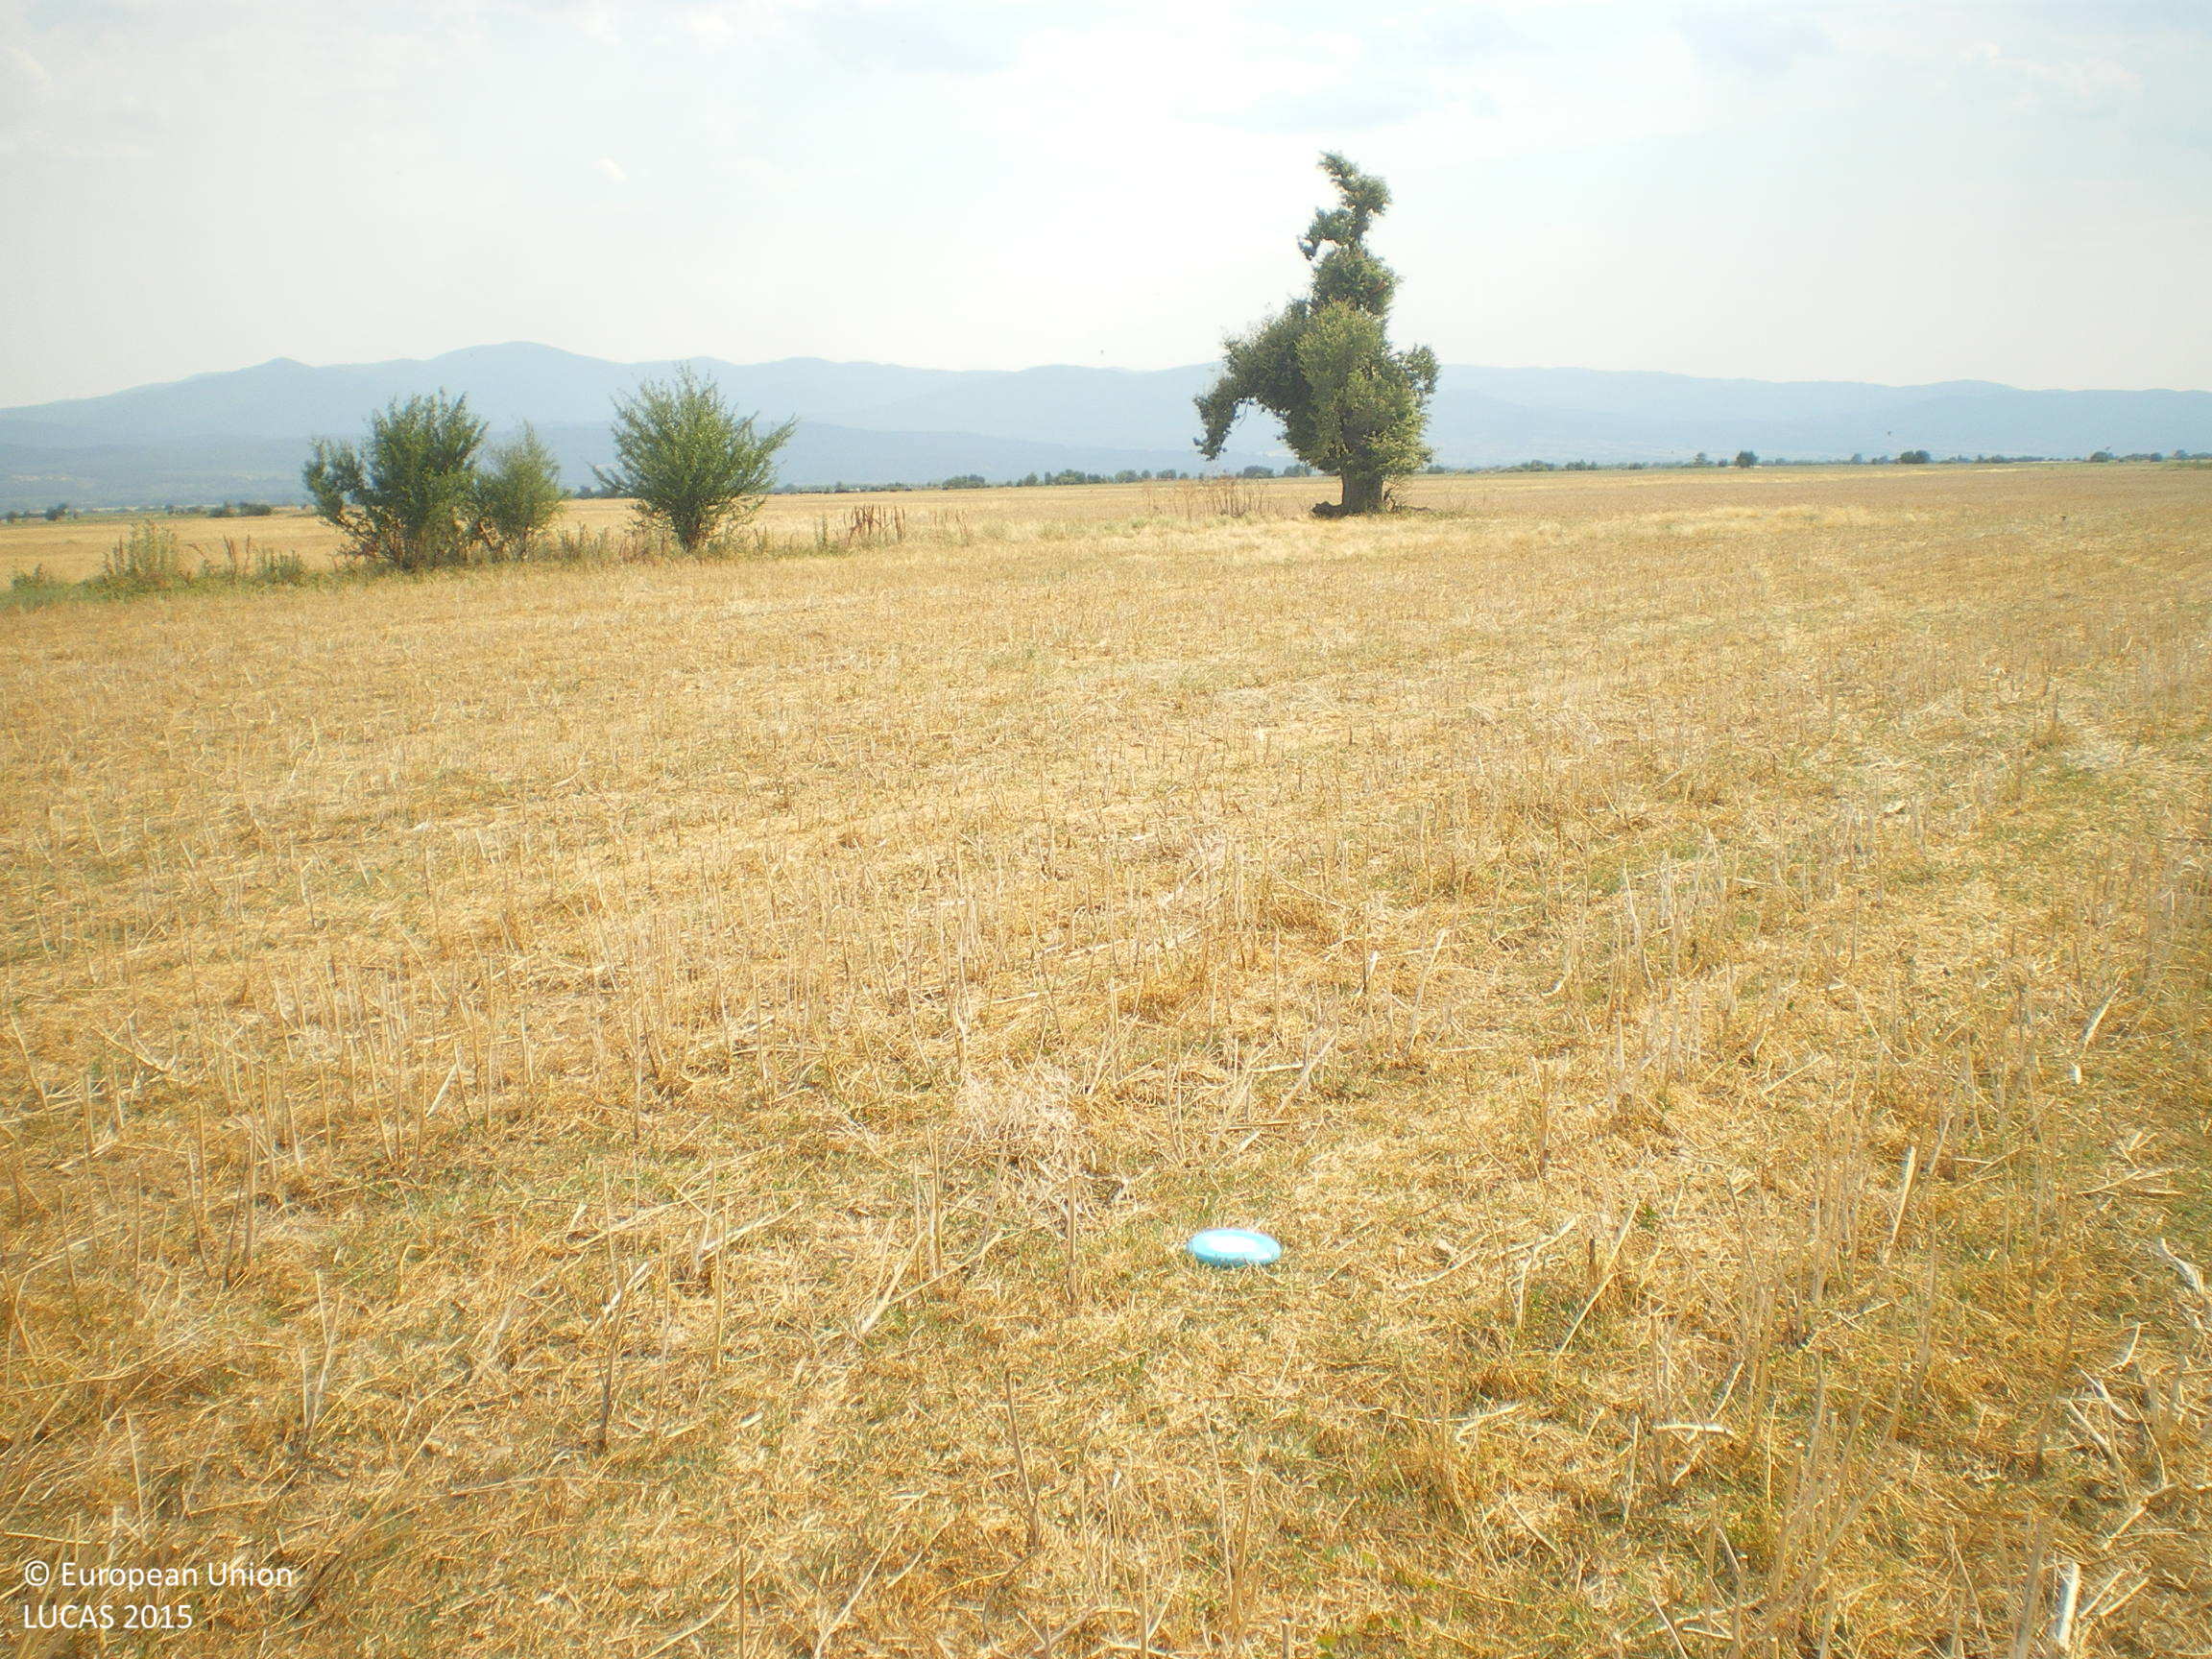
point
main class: Cropland
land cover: Rape and turnip rape
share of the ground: < 10 %
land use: Agriculture (excluding fallow land and kitchen gardens)
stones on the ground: > 50 %
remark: Harvested field
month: July
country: BG
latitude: 42.6576
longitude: 25.1804
